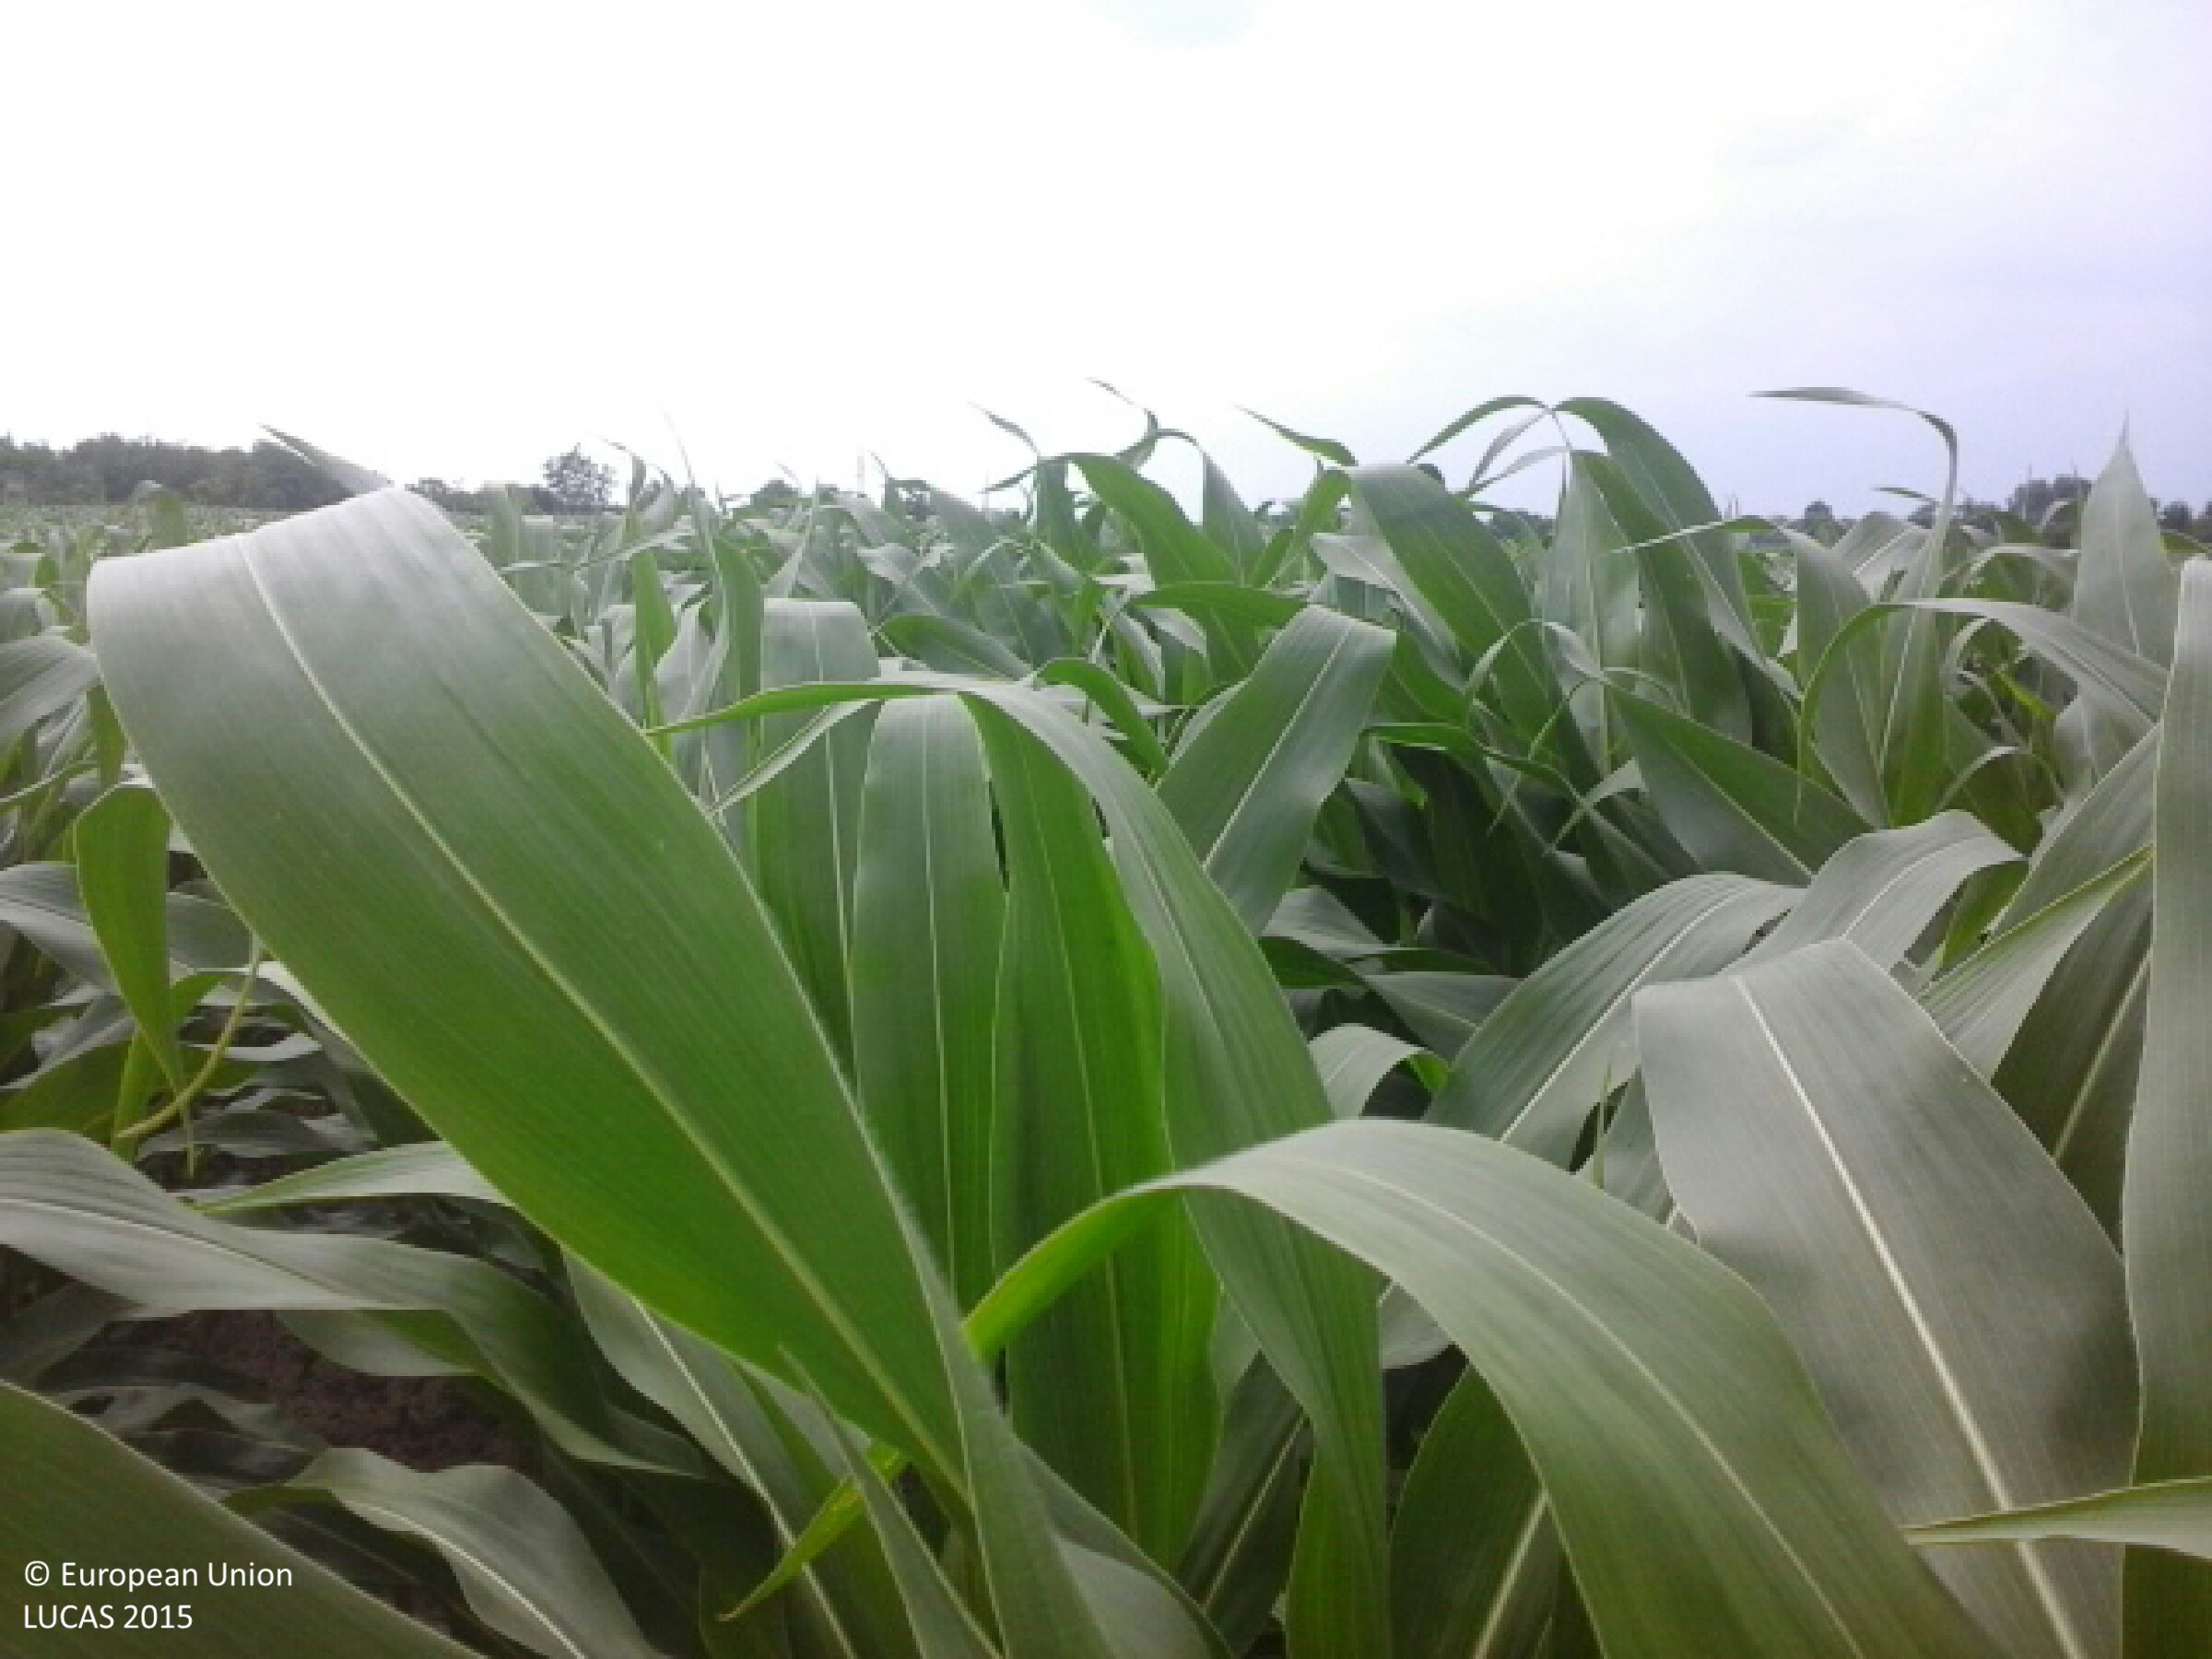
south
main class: Cropland
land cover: Maize
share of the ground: > 75 %
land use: Agriculture (excluding fallow land and kitchen gardens)
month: June
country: HU
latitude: 48.1324
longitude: 21.9707
